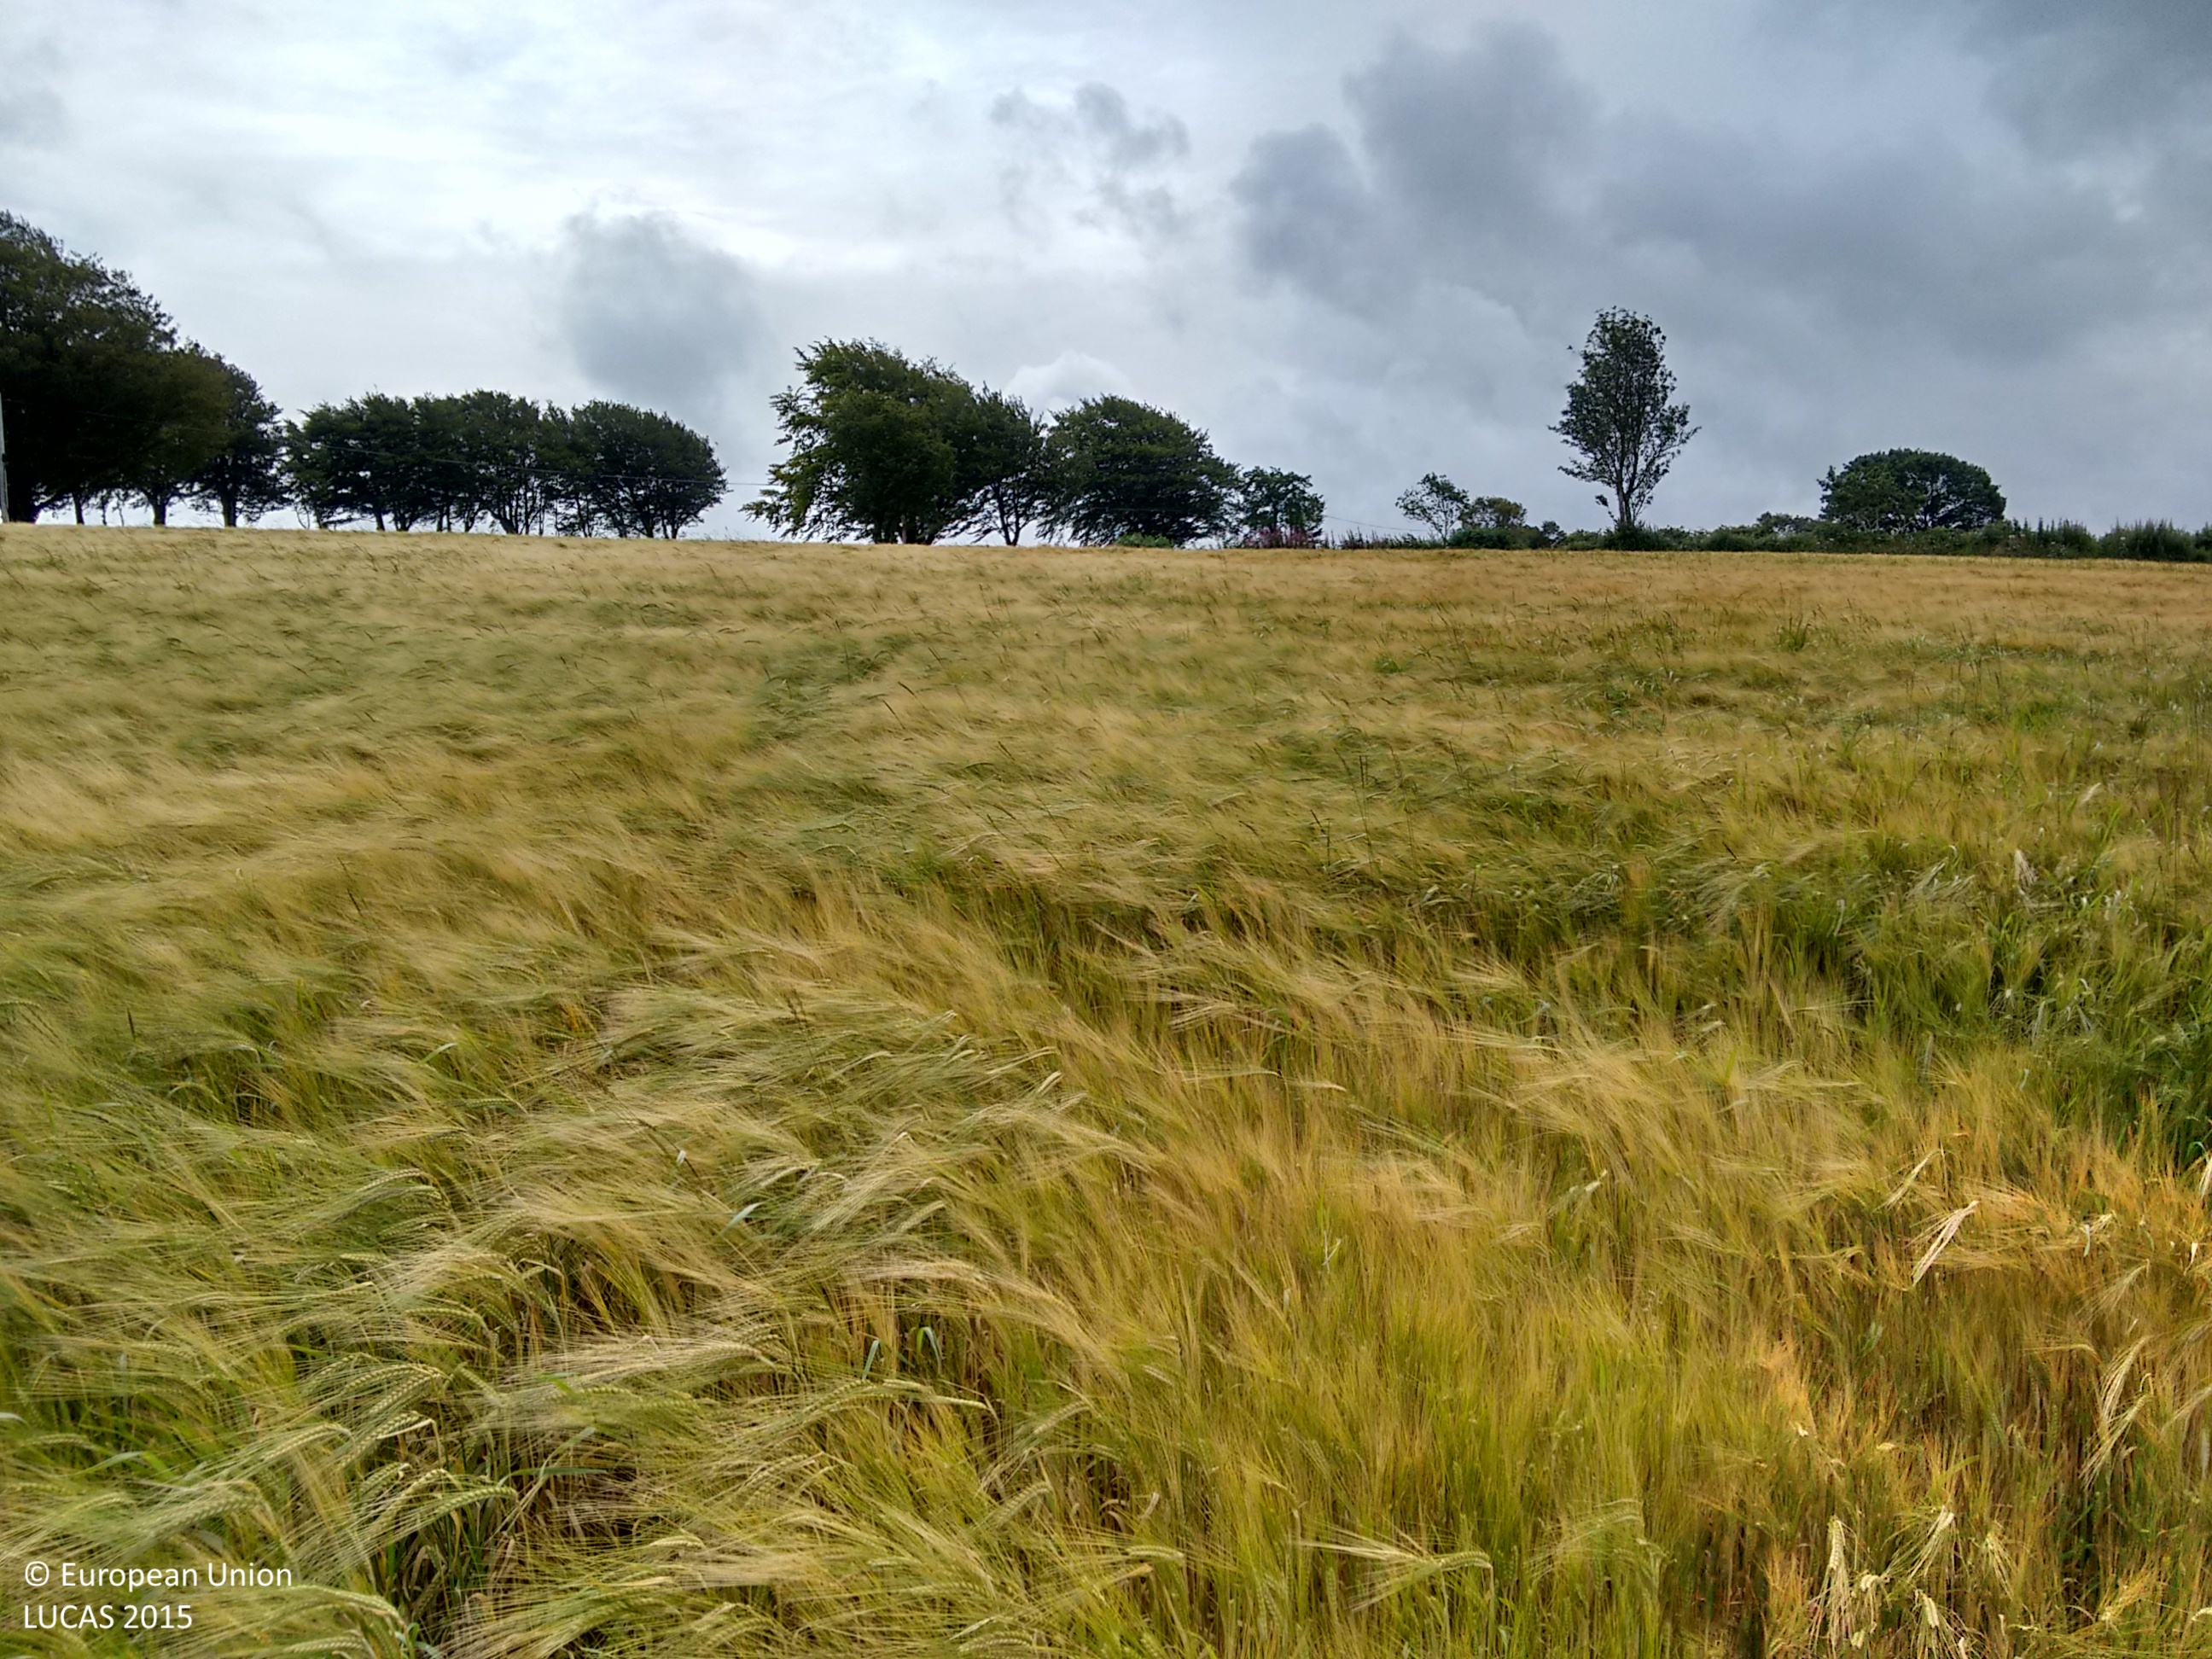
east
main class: Cropland
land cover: Barley
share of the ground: > 75 %
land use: Agriculture (excluding fallow land and kitchen gardens)
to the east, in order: Barley; Fences; Managed hedges; Single bushes/trees; Fences; Barley; Fences; Managed hedges; Electric lines; Paved roads, cycling and walking lanes; Managed hedges; Grassland without tree/shrub cover; Lines of trees
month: August
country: GB
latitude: 51.9739
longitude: -4.5028
